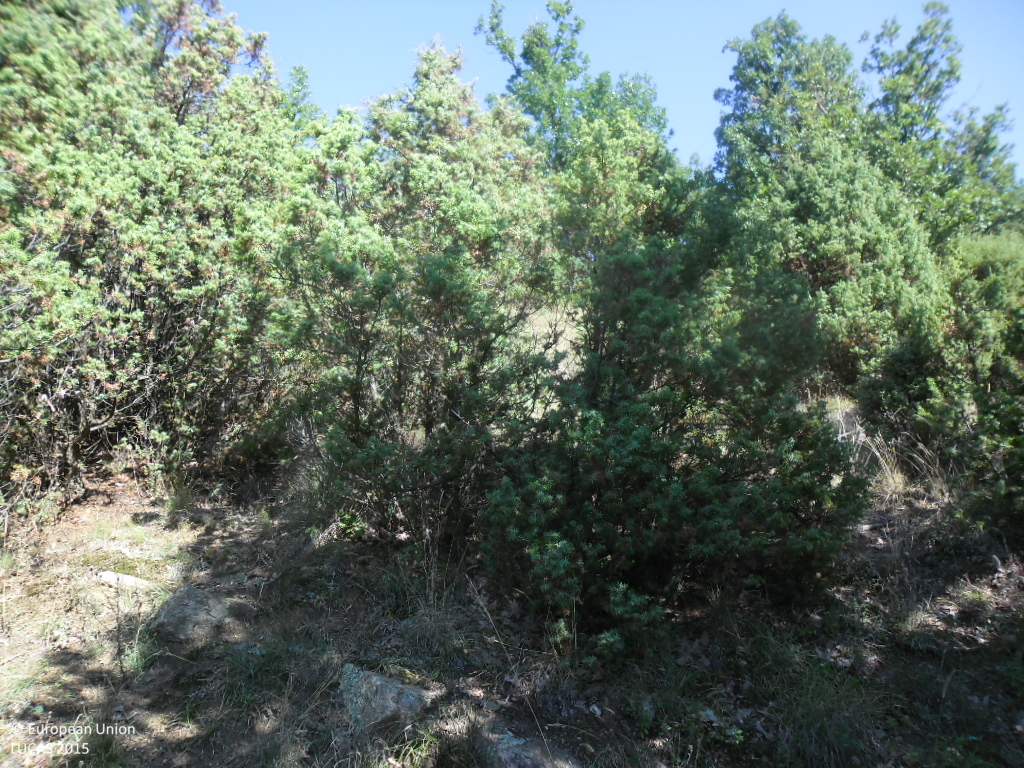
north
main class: Woodland
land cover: Other mixed woodland
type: hemiboreal forest and nemoral coniferous forest and mixed broadleaved-coniferous forest
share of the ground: > 75 %
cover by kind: coniferous forest trees 60 %, broadleaved forest trees 40 %
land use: Forestry
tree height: < 5 m
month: September
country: BG
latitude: 42.0055
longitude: 23.1980
